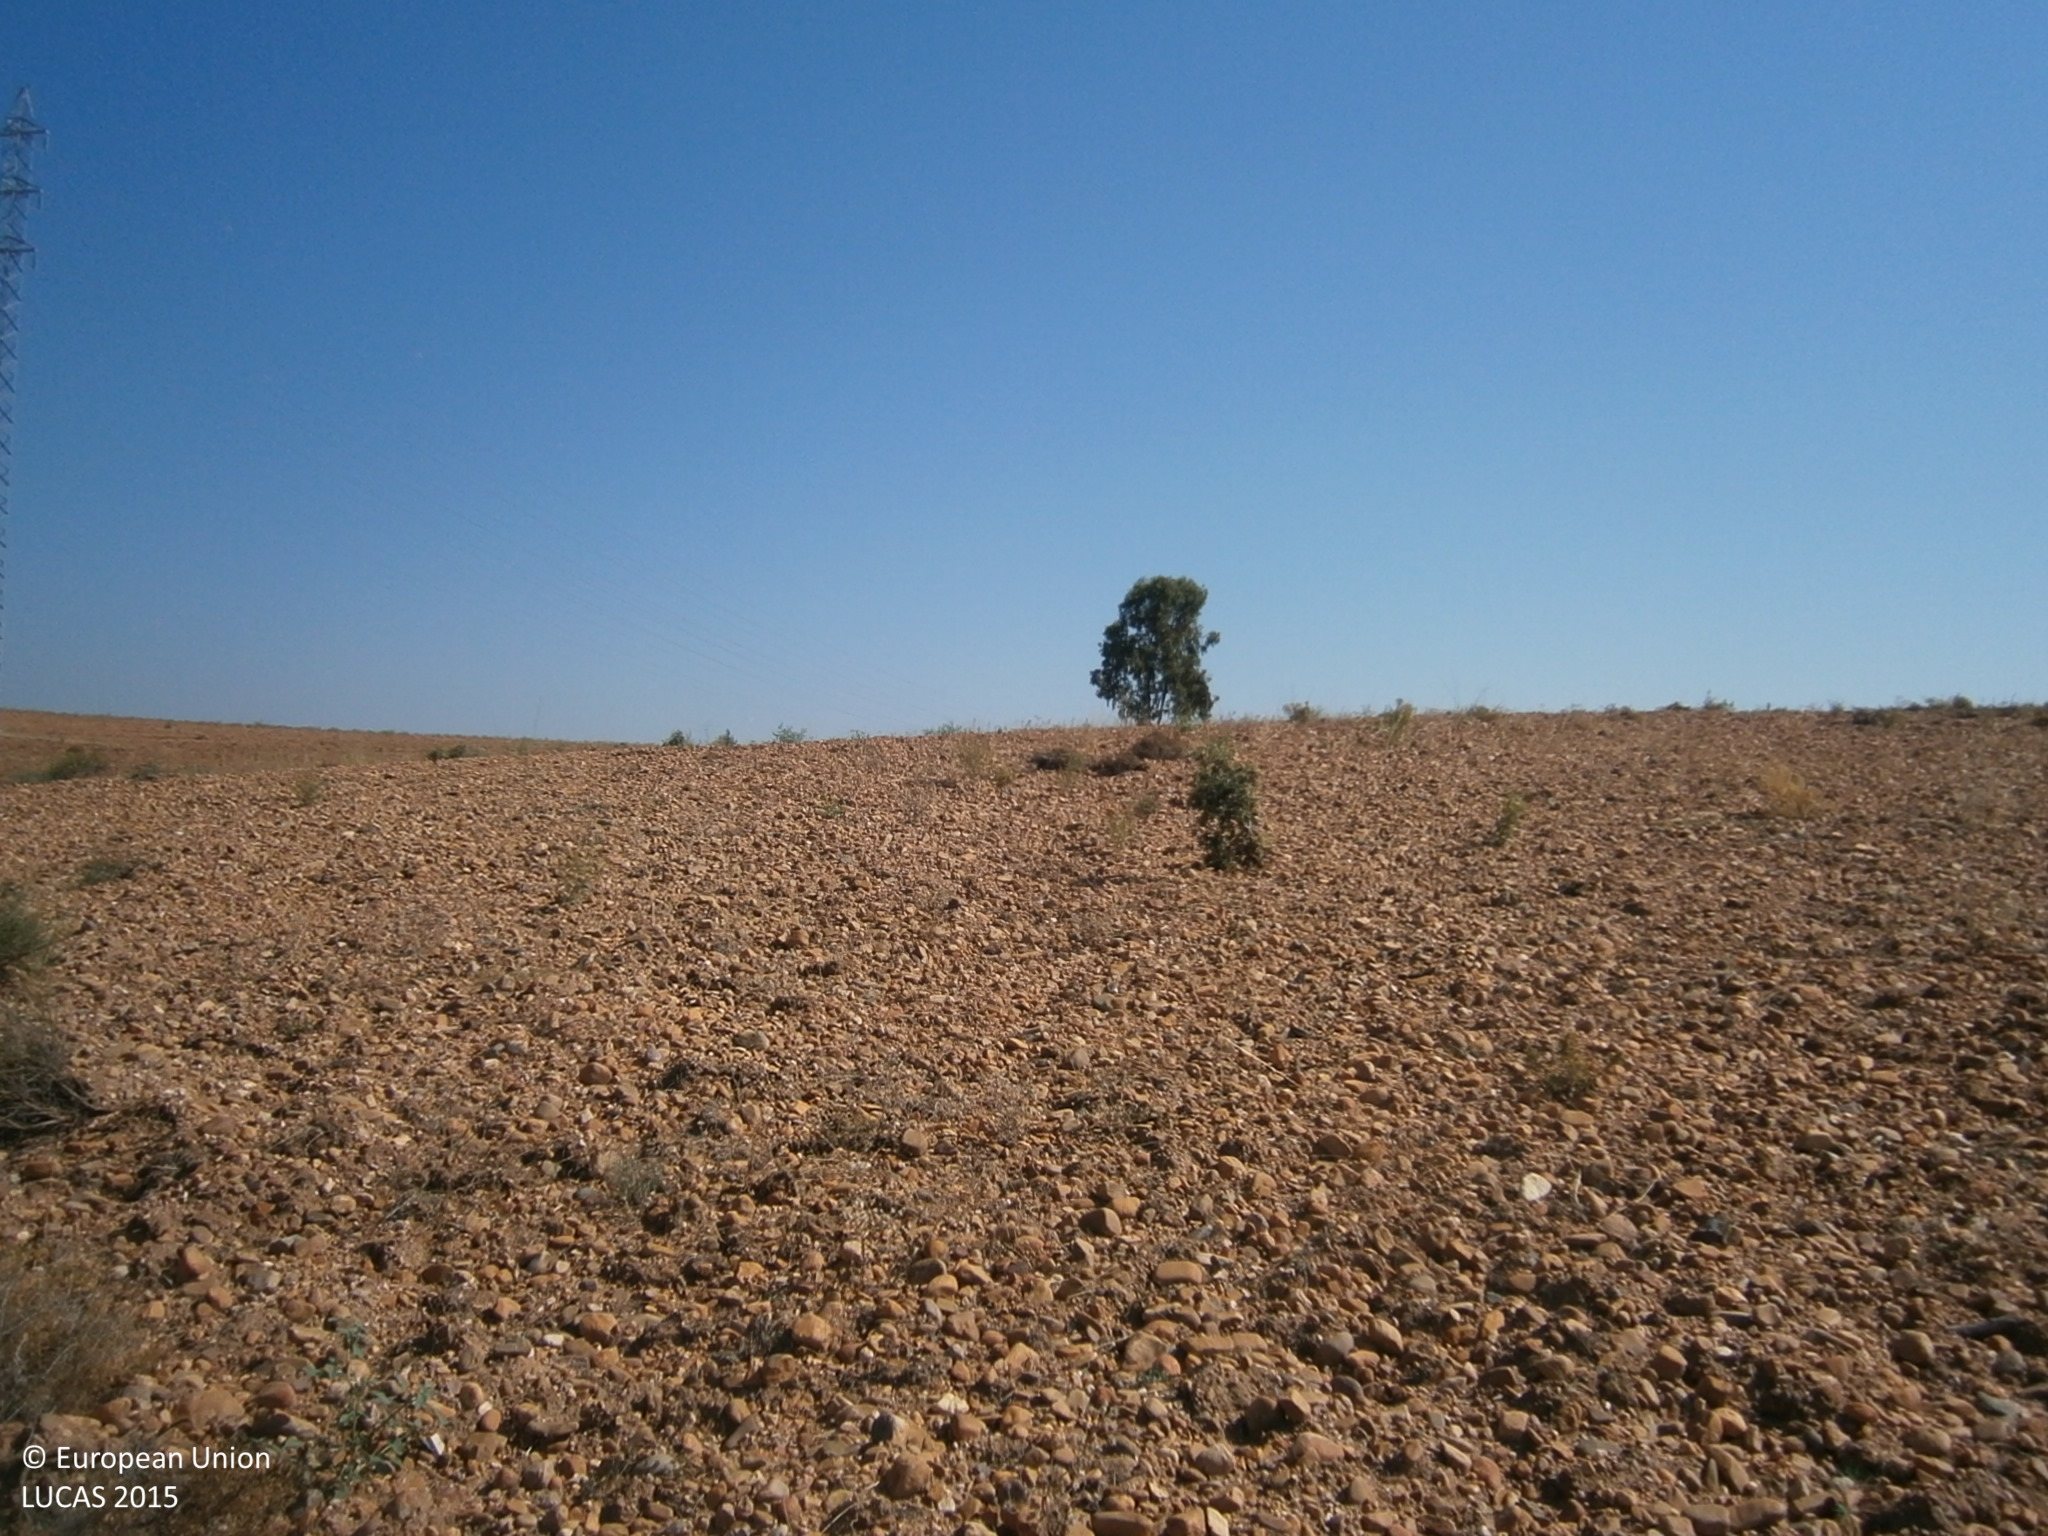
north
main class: Grassland
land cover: Spontaneously vegetated surfaces
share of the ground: 10 - 25 %
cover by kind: unconsolidated bare surface 85 %, herbaceous plants 15 %
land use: Fallow land
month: June
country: ES
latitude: 38.8427
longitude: -6.8060
